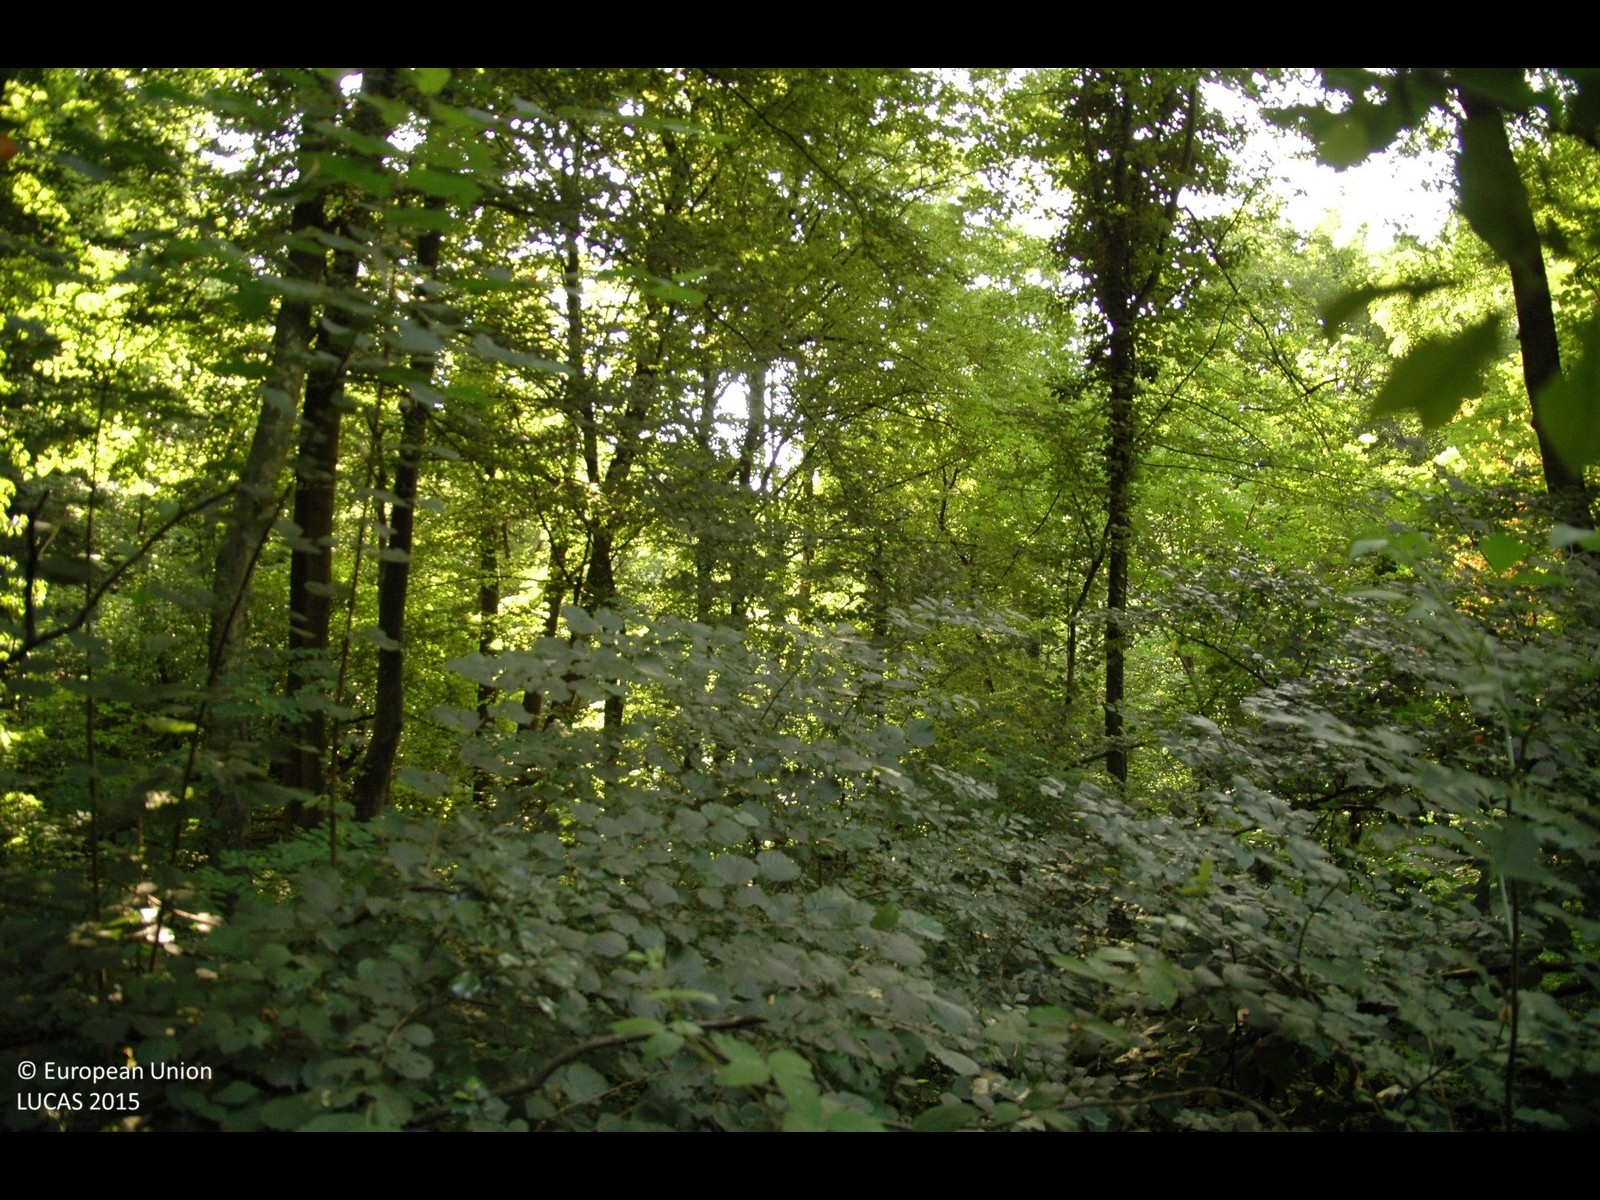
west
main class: Woodland
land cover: Broadleaved woodland
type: mesophytic deciduous forest
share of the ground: > 75 %
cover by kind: broadleaved forest trees 100 %
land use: Forestry
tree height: > 5 m
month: July
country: HR
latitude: 46.0305
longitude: 16.1356
